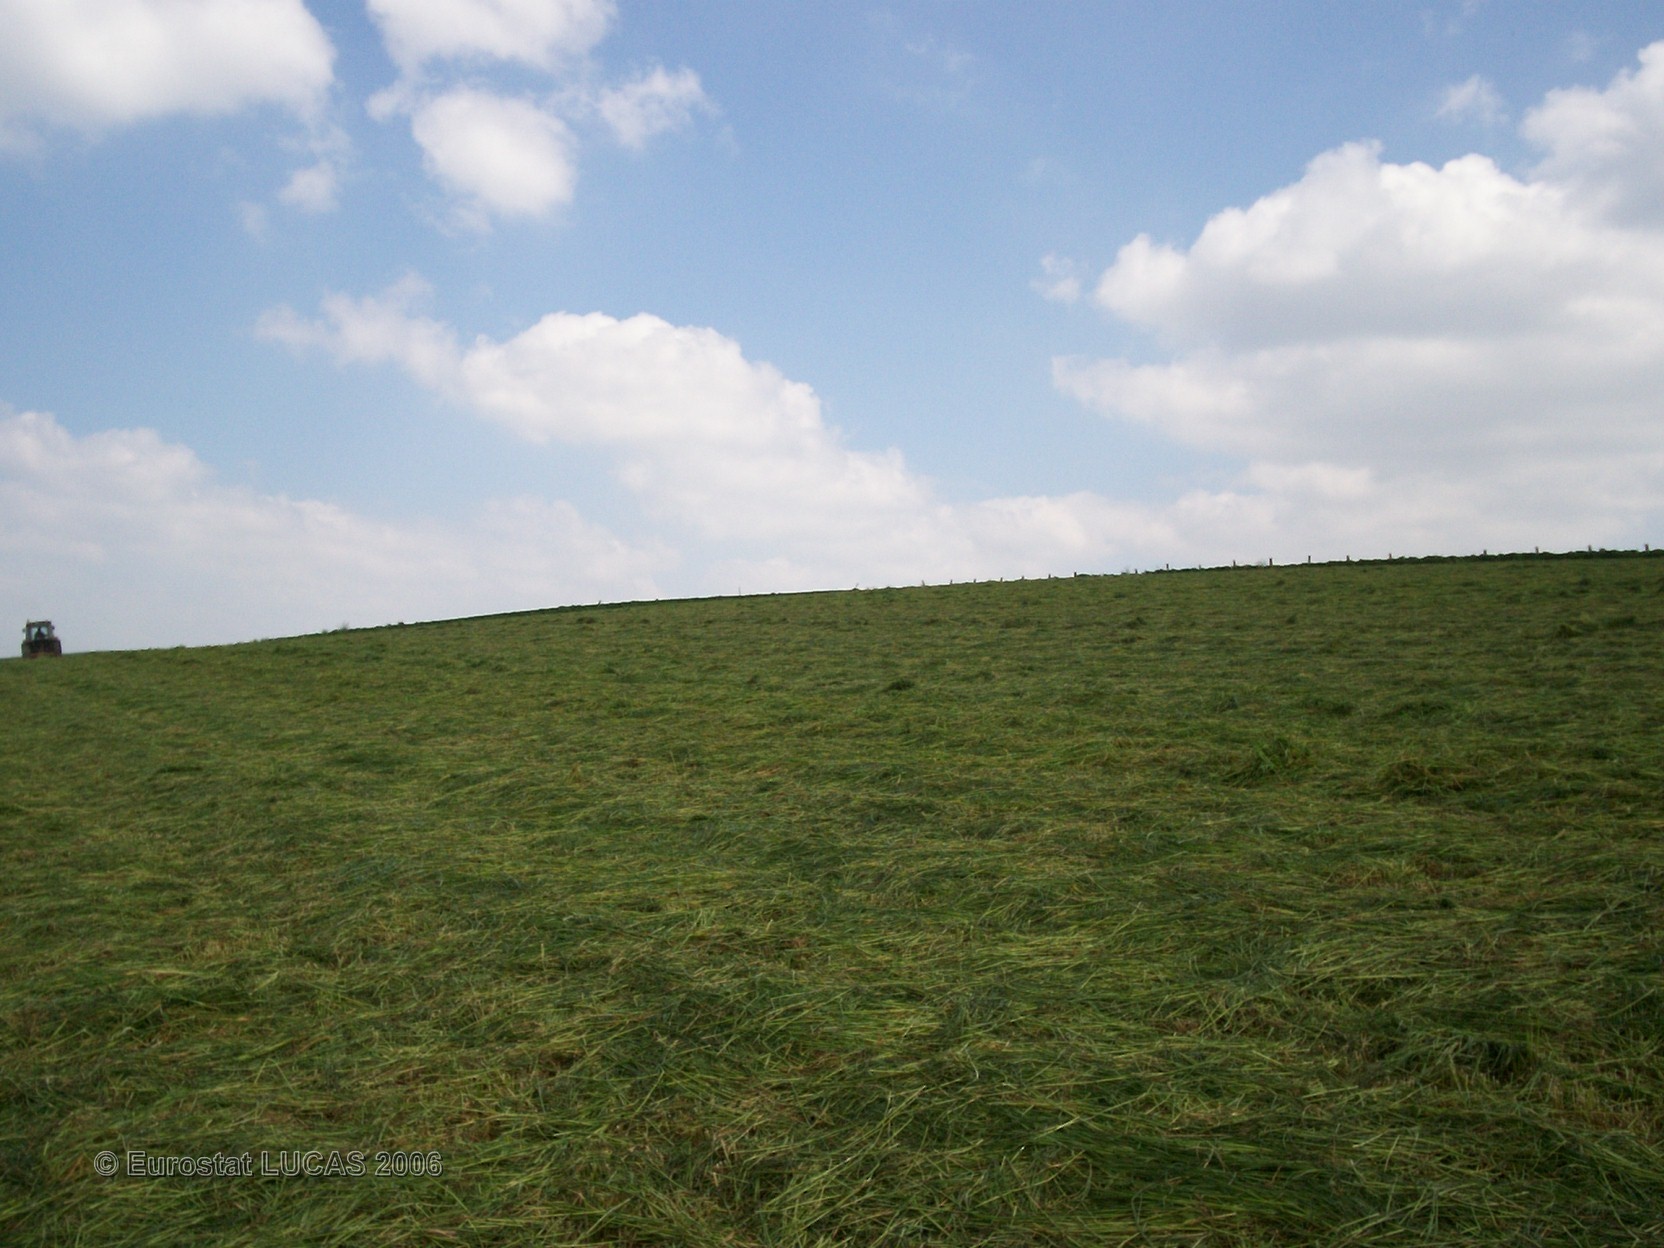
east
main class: Grassland
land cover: Grassland without tree/shrub cover
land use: Agriculture (excluding fallow land and kitchen gardens)
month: May
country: FR
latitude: 48.3347
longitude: -3.6657
